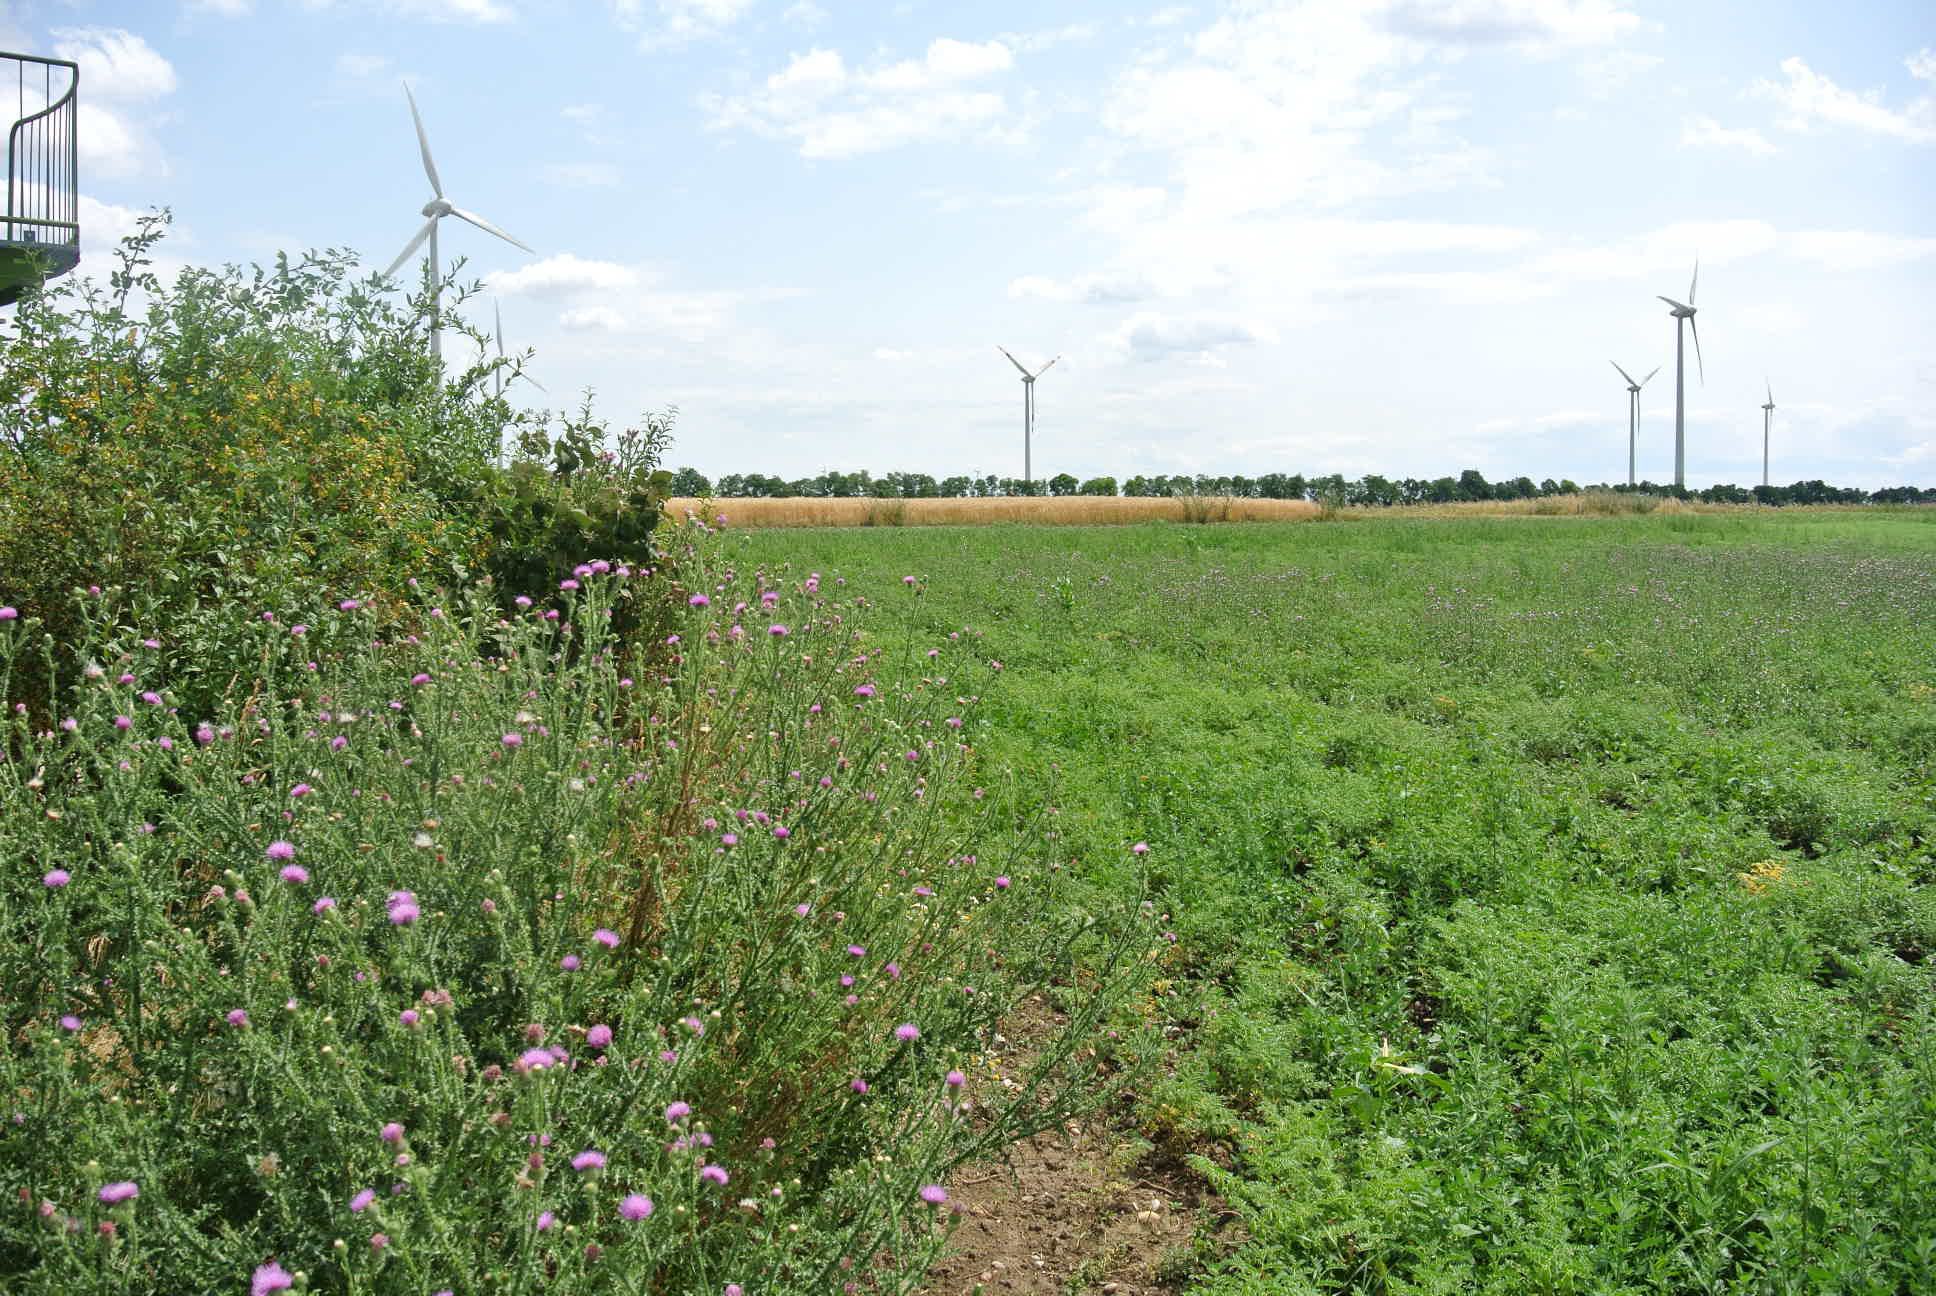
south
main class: Cropland
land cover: Dry pulses
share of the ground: > 75 %
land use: Agriculture (excluding fallow land and kitchen gardens)
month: July
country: AT
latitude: 47.9529
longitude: 16.9026
